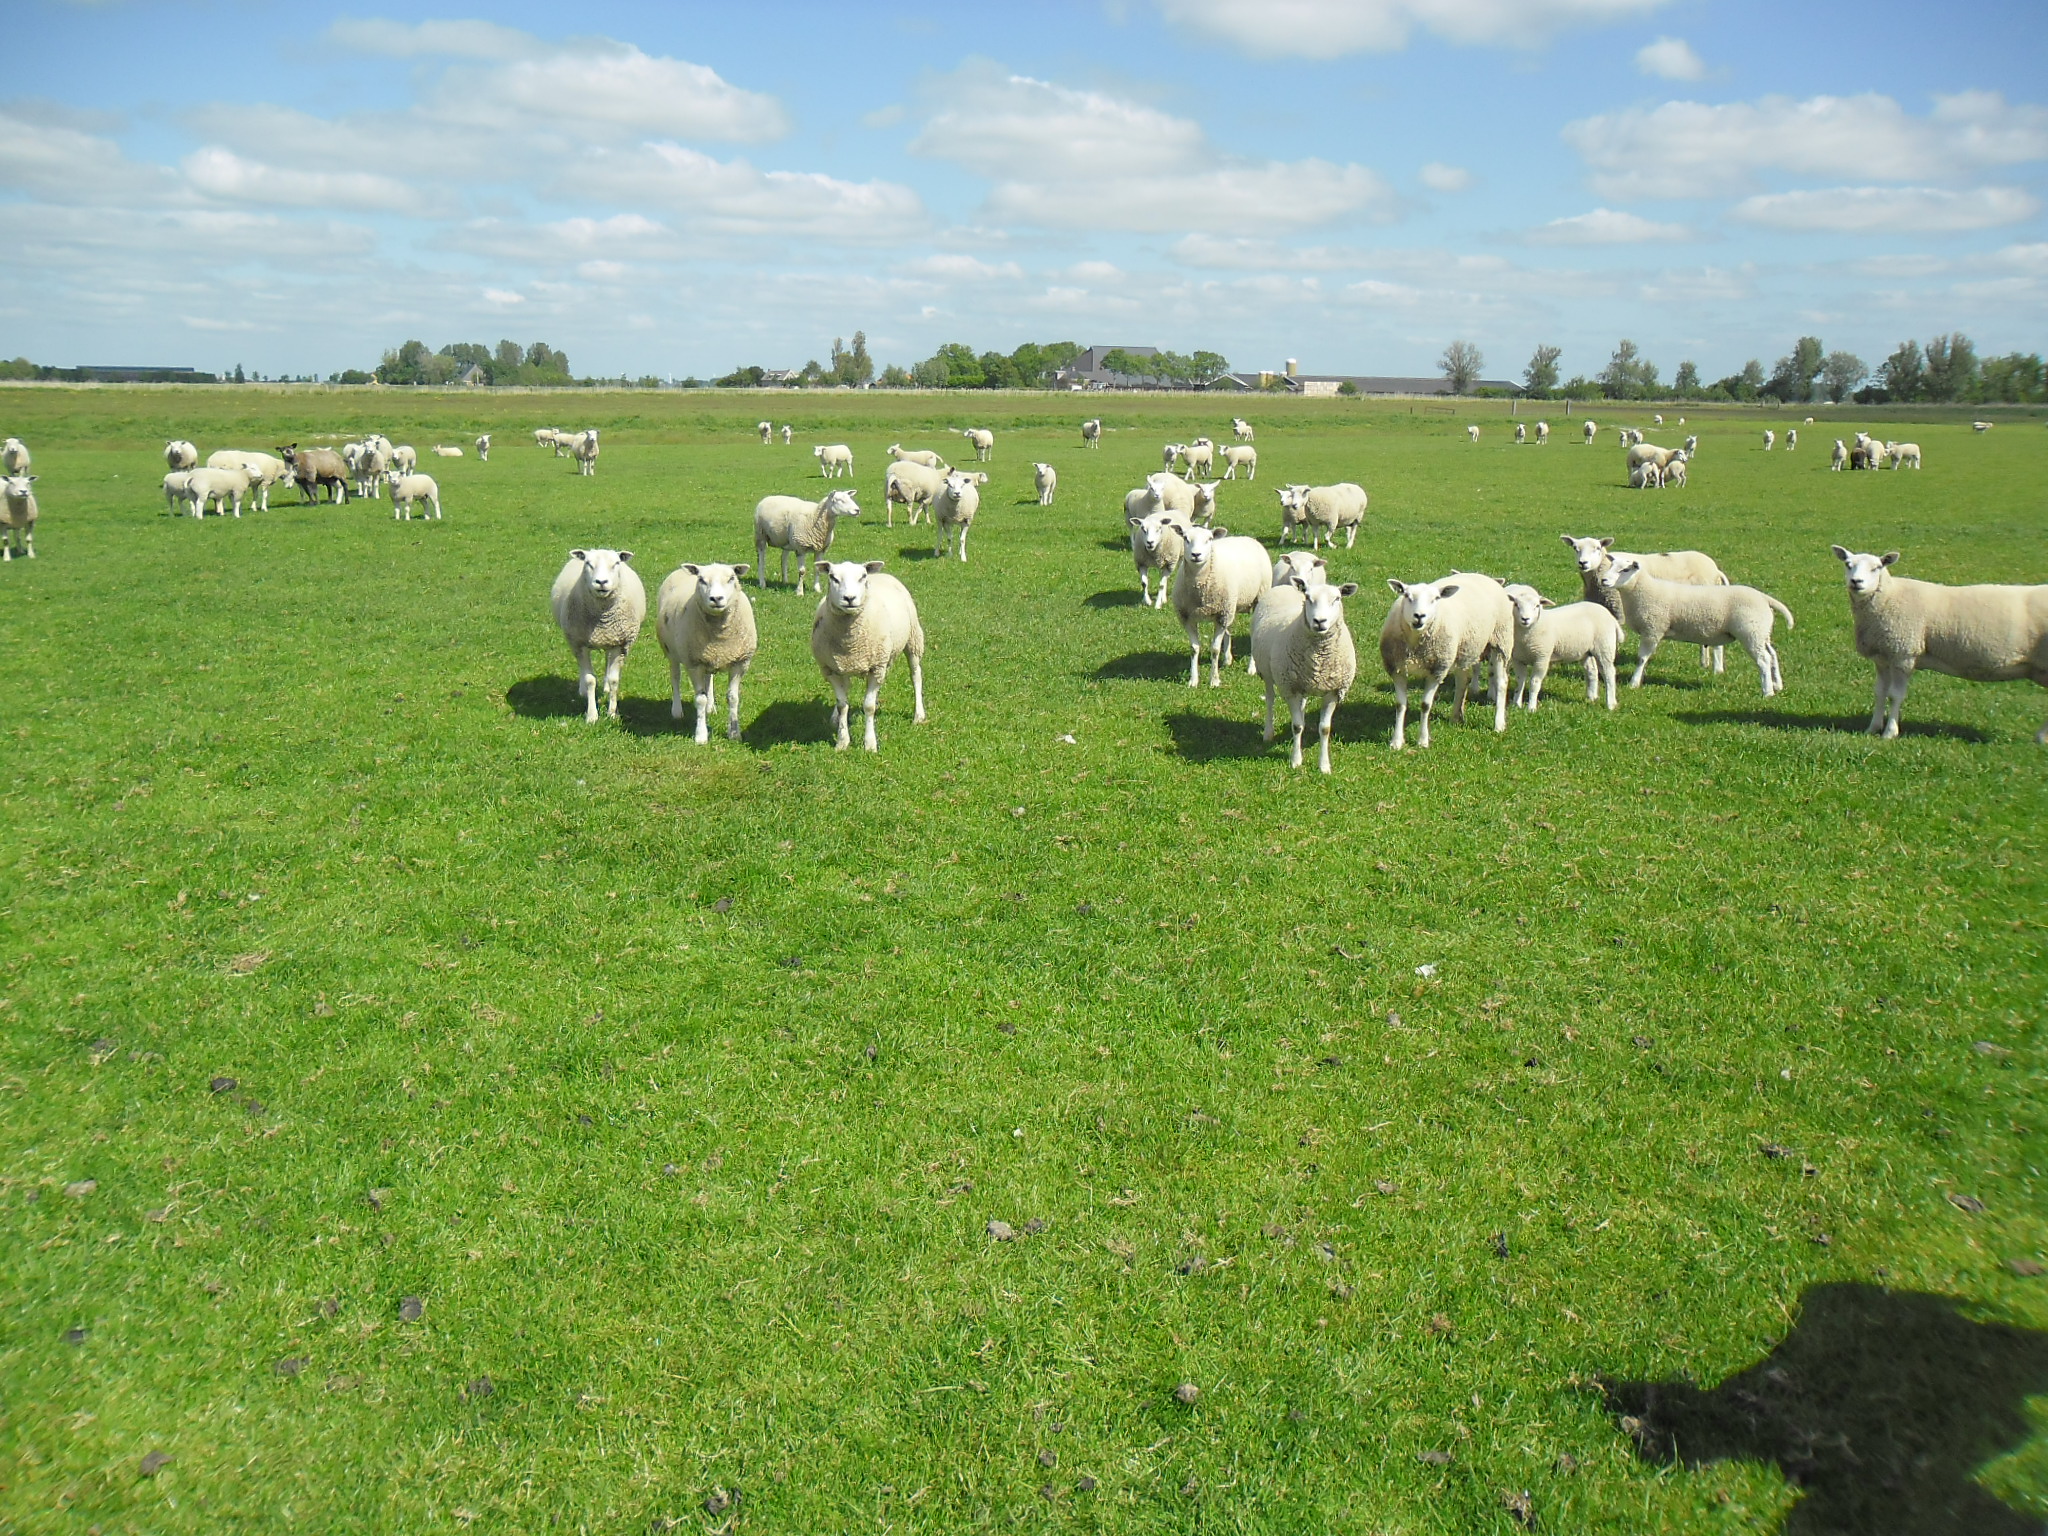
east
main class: Grassland
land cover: Grassland without tree/shrub cover
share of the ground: > 75 %
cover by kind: herbaceous plants 100 %
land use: Agriculture (excluding fallow land and kitchen gardens)
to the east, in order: Grassland without tree/shrub cover; Ditches and canals; Grassland without tree/shrub cover; Ditches and canals; Grassland without tree/shrub cover; Inland fresh running water; Grassland without tree/shrub cover
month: June
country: NL
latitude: 53.2123
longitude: 5.5515
